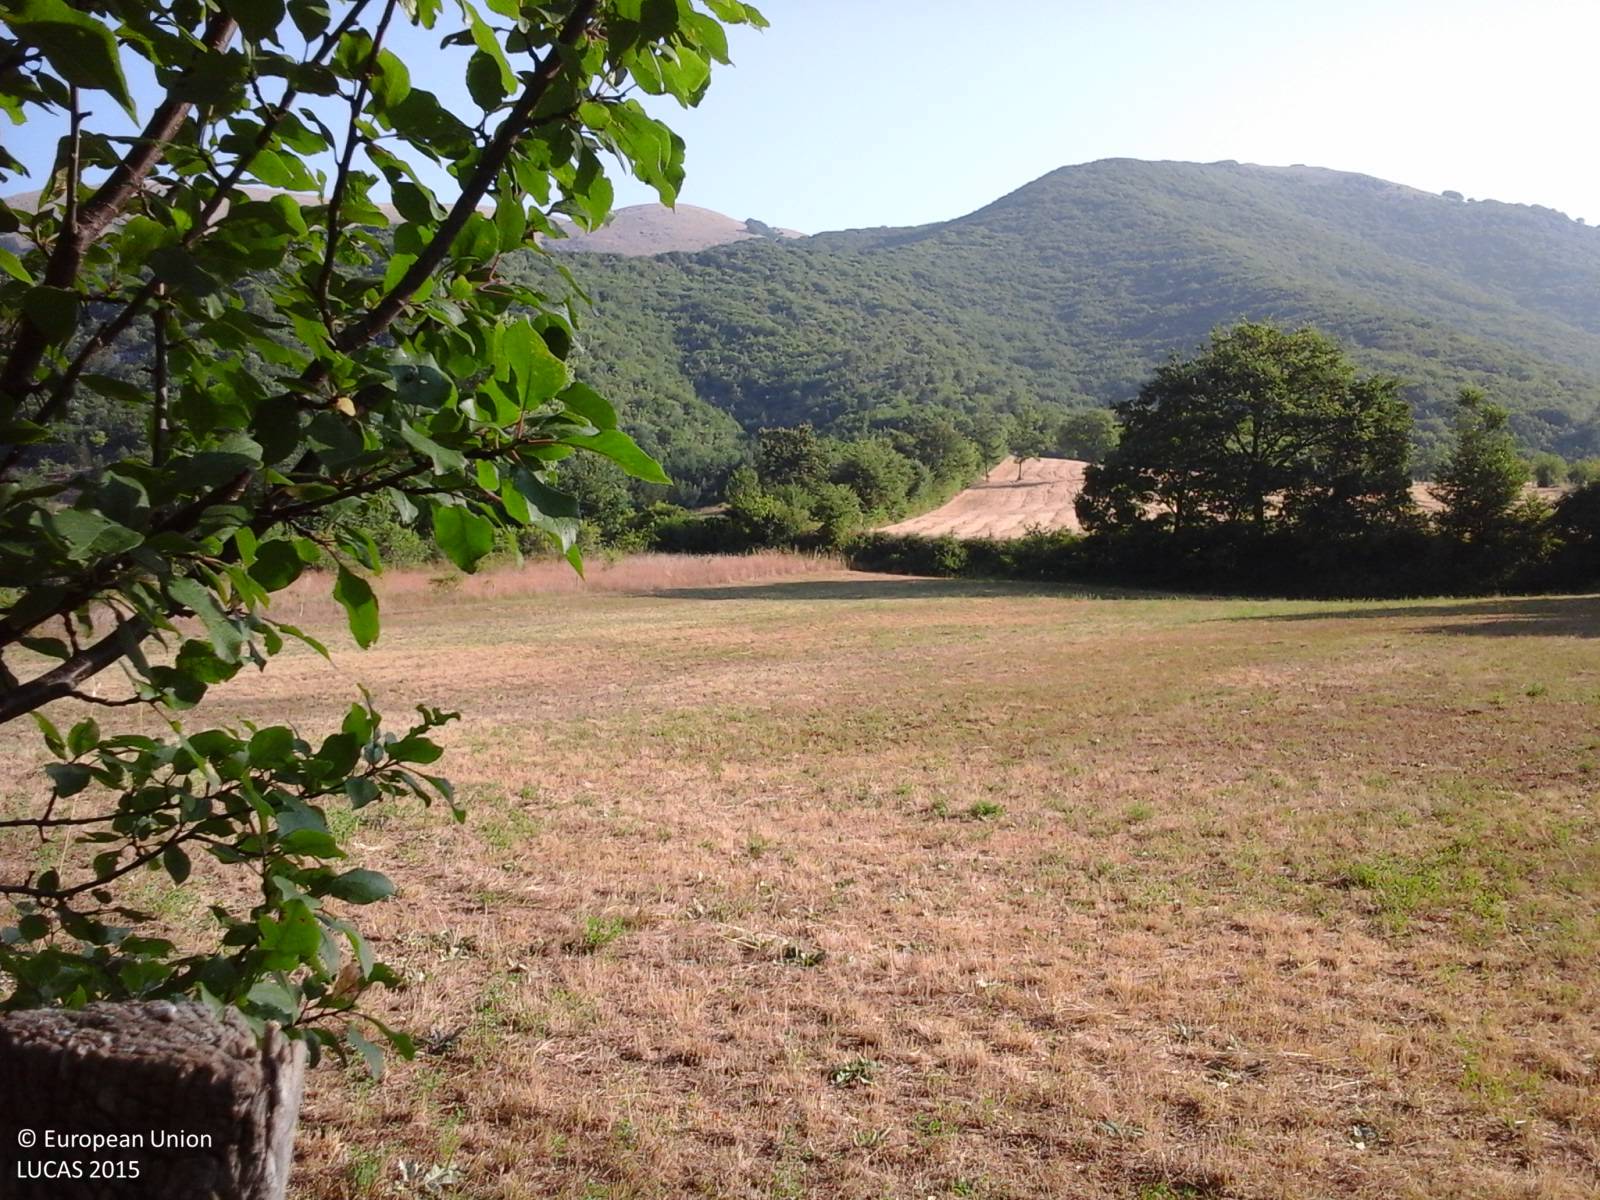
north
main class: Grassland
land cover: Spontaneously vegetated surfaces
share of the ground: > 75 %
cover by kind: herbaceous plants 100 %
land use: Agriculture (excluding fallow land and kitchen gardens)
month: July
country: IT
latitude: 42.3690
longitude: 13.1833
